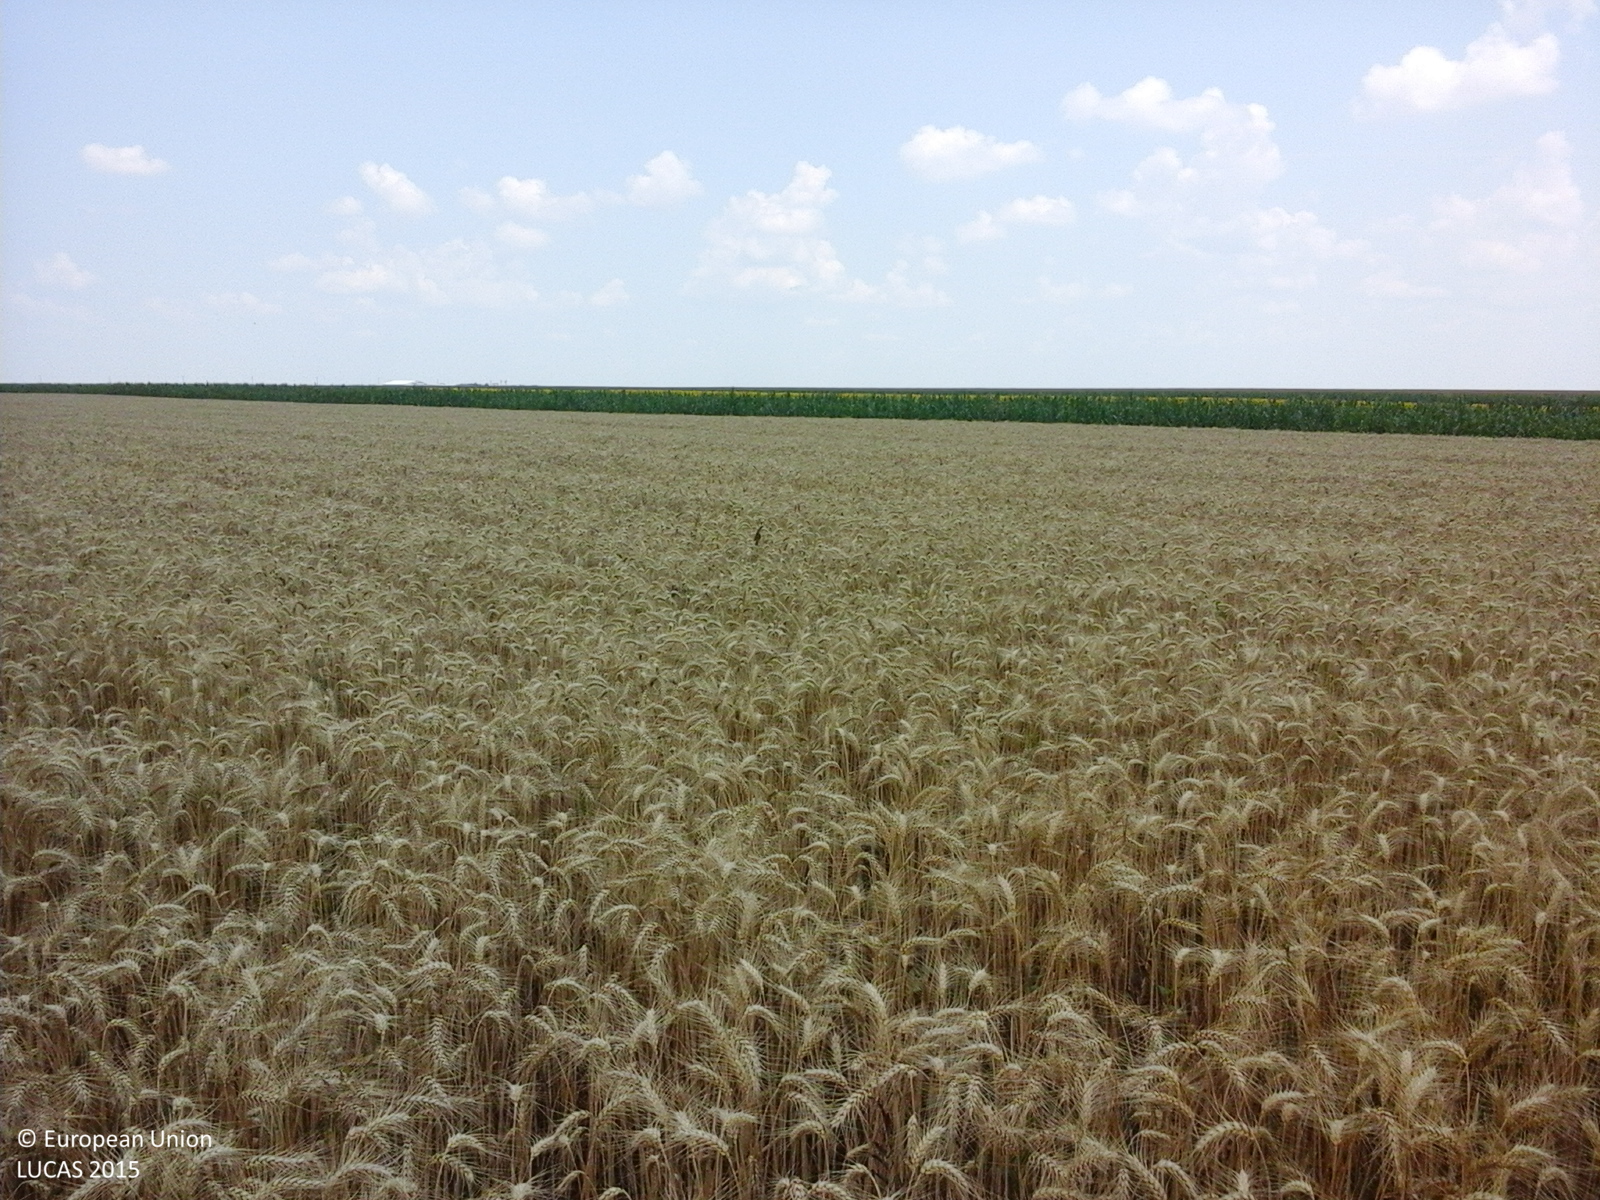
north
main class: Cropland
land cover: Common wheat
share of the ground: > 75 %
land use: Agriculture (excluding fallow land and kitchen gardens)
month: July
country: RO
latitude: 43.9567
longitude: 25.1961
